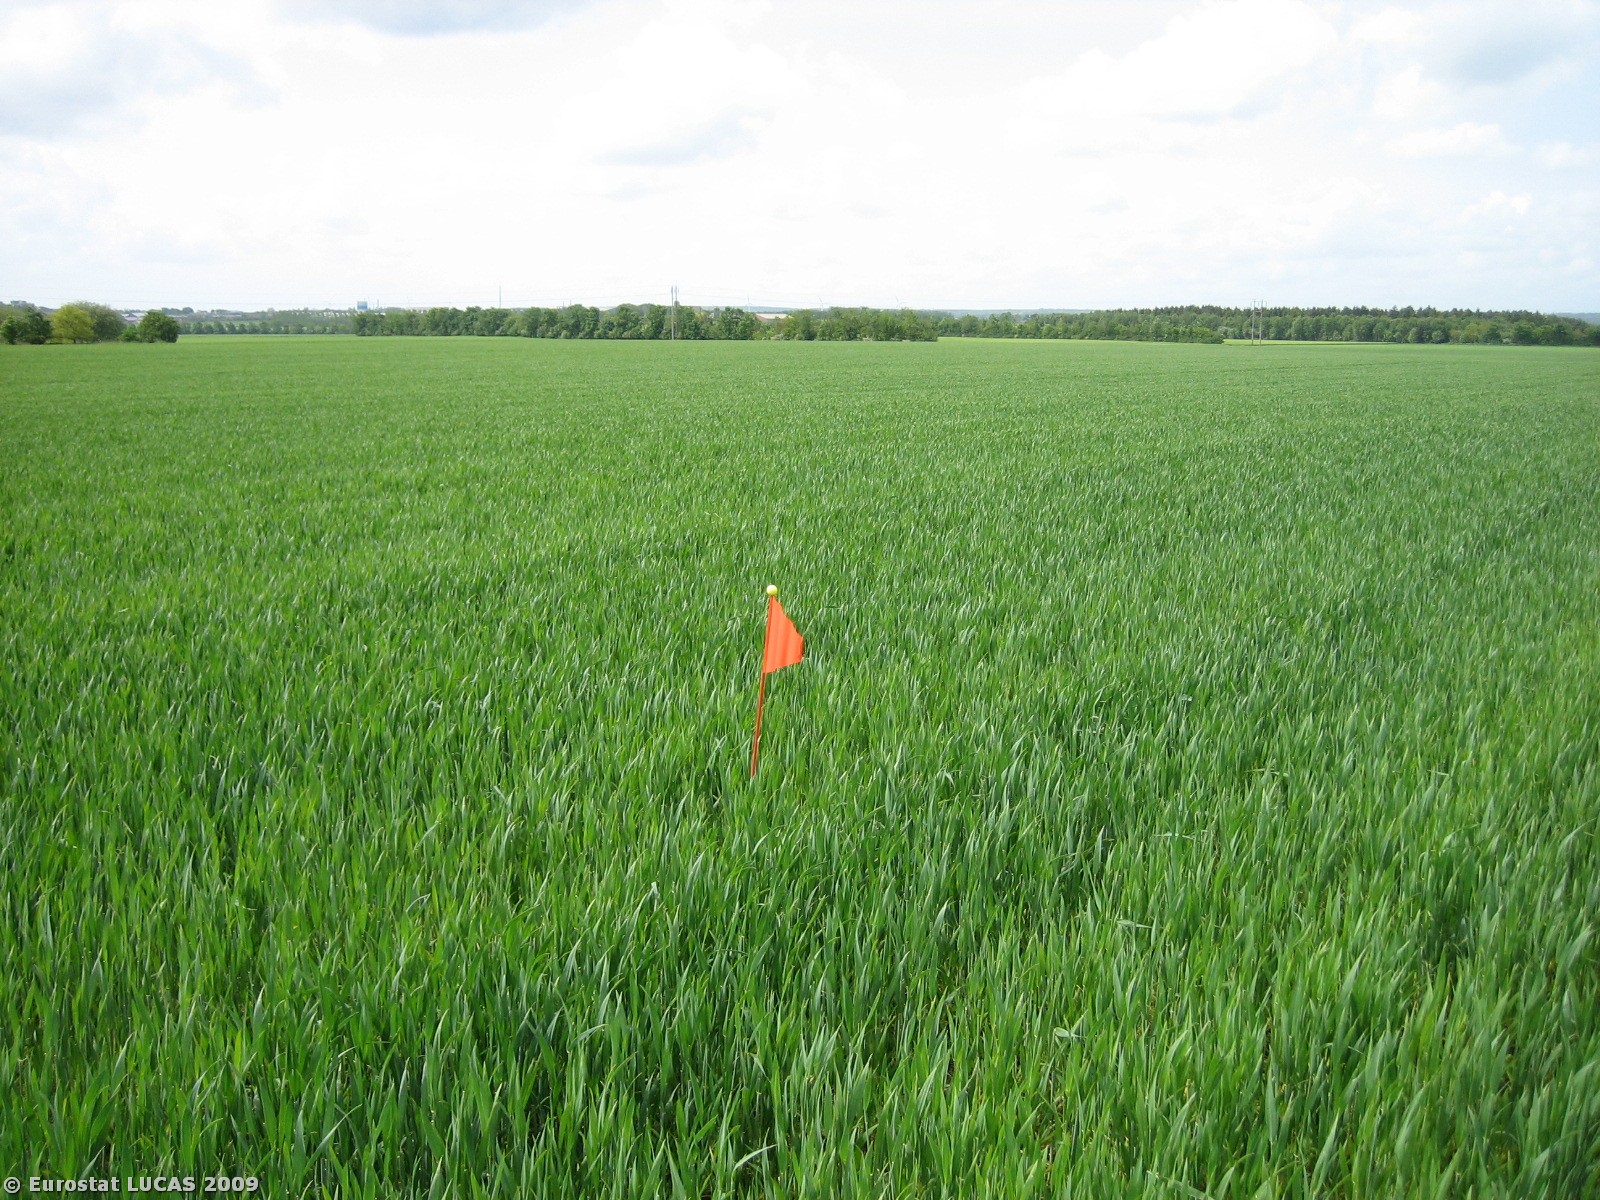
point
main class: Cropland
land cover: Common wheat
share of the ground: > 75 %
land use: Agriculture (excluding fallow land and kitchen gardens)
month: May
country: DK
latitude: 56.2180
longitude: 8.7920
